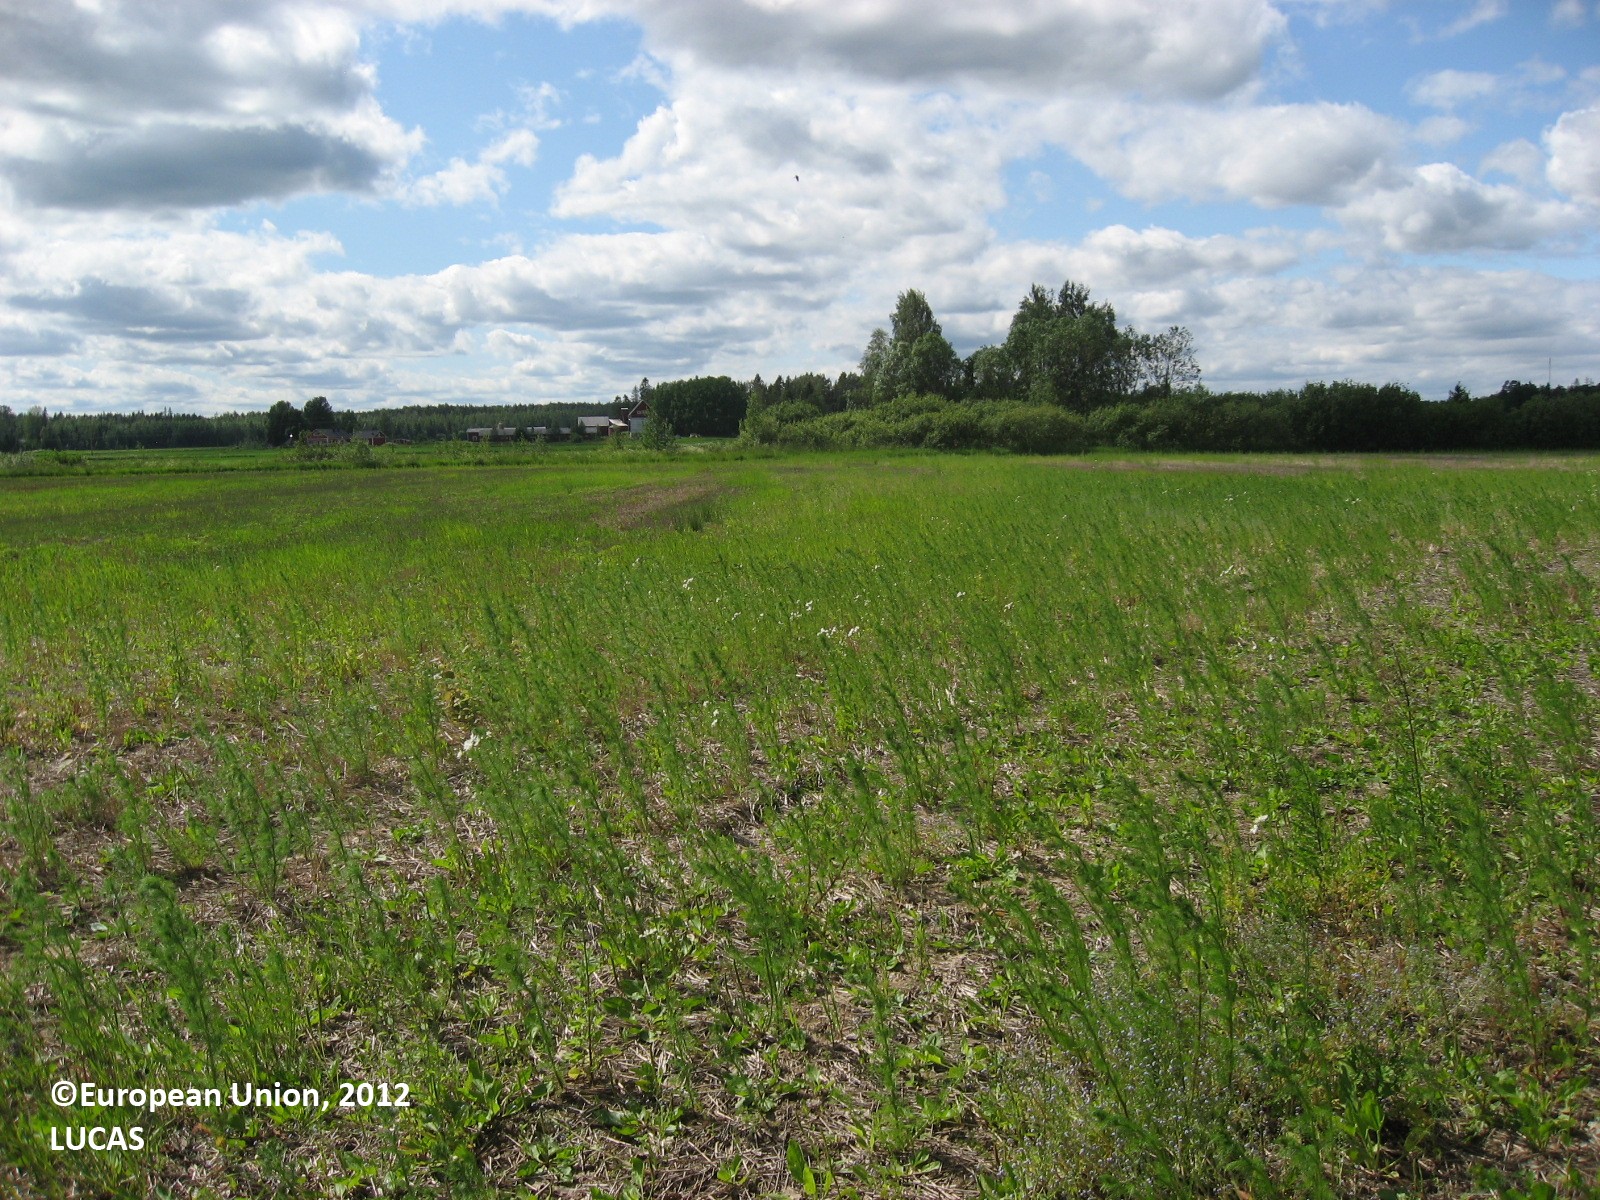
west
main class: Grassland
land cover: Spontaneously vegetated surfaces
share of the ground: 25 - 50 %
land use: Fallow land
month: June
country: FI
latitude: 60.6054
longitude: 26.4647
